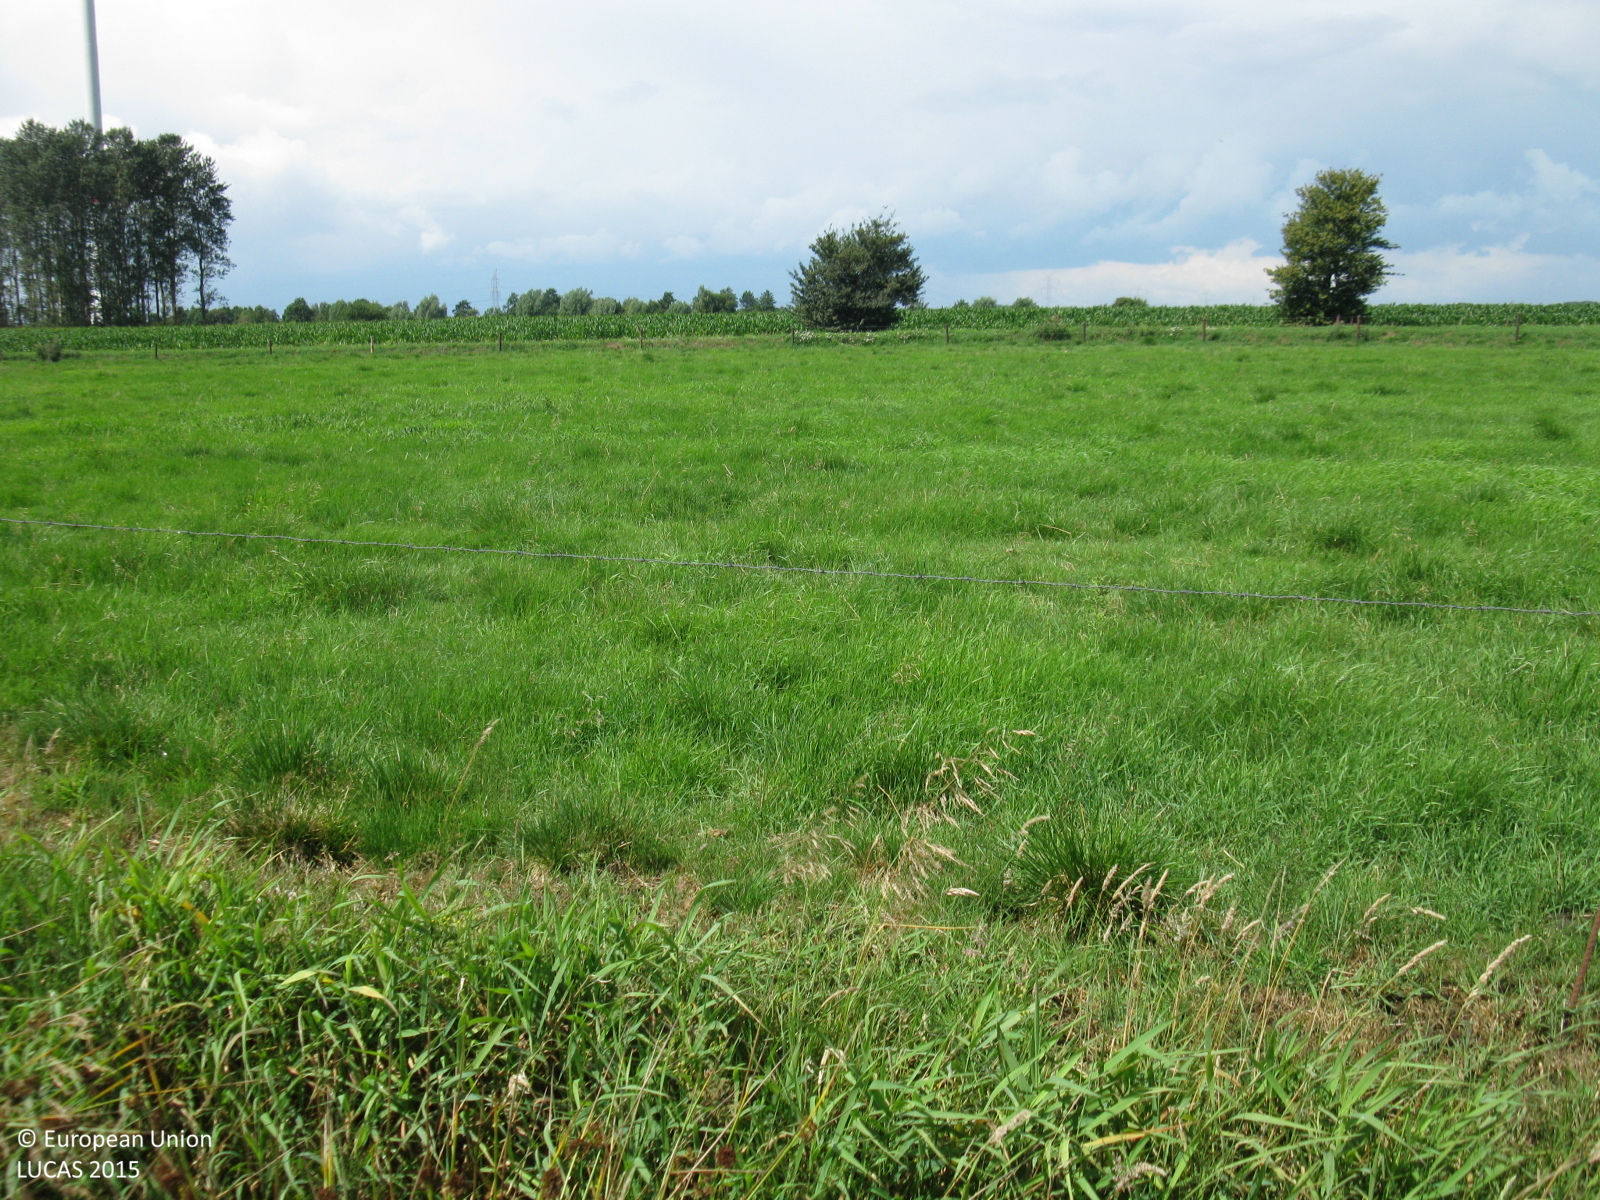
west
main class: Grassland
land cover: Grassland without tree/shrub cover
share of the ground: > 75 %
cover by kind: herbaceous plants 100 %
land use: Agriculture (excluding fallow land and kitchen gardens)
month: July
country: DE
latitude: 53.1240
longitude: 8.5809
